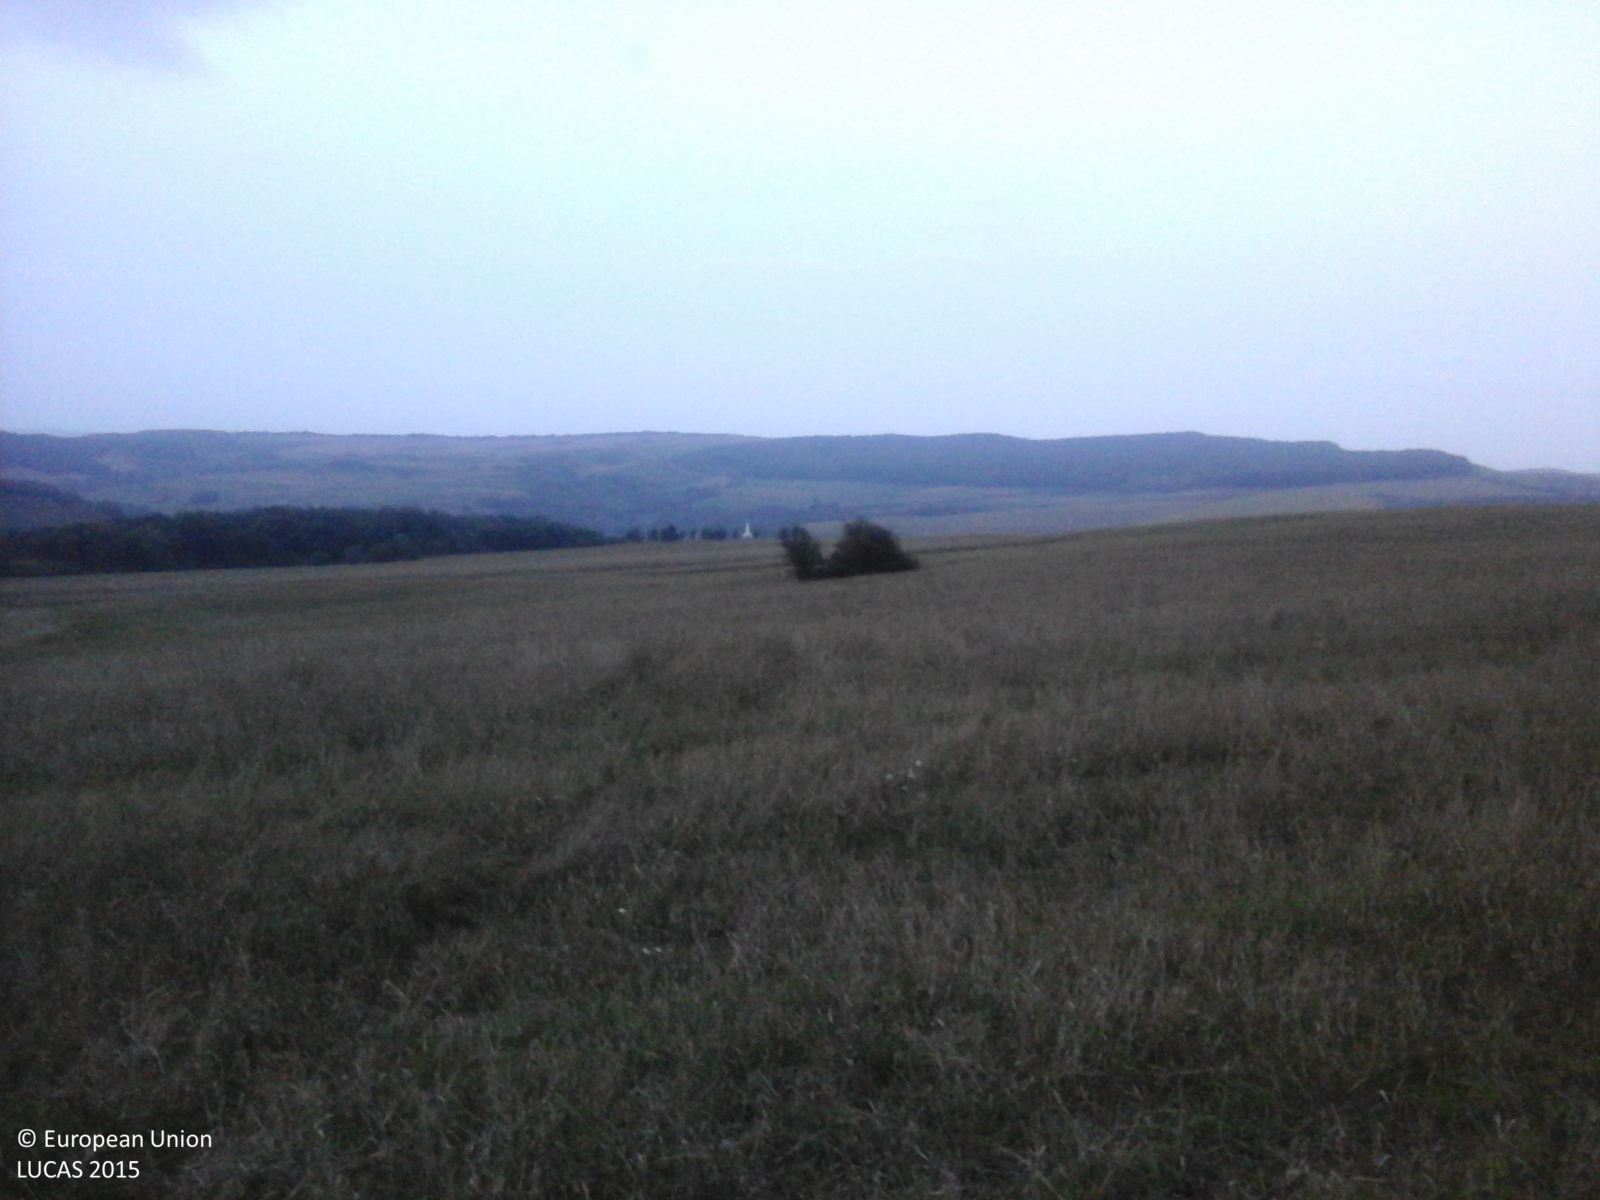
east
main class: Grassland
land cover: Grassland without tree/shrub cover
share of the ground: > 75 %
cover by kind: herbaceous plants 100 %
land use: Agriculture (excluding fallow land and kitchen gardens)
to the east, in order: Grassland without tree/shrub cover
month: October
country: RO
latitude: 46.3212
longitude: 23.8529
